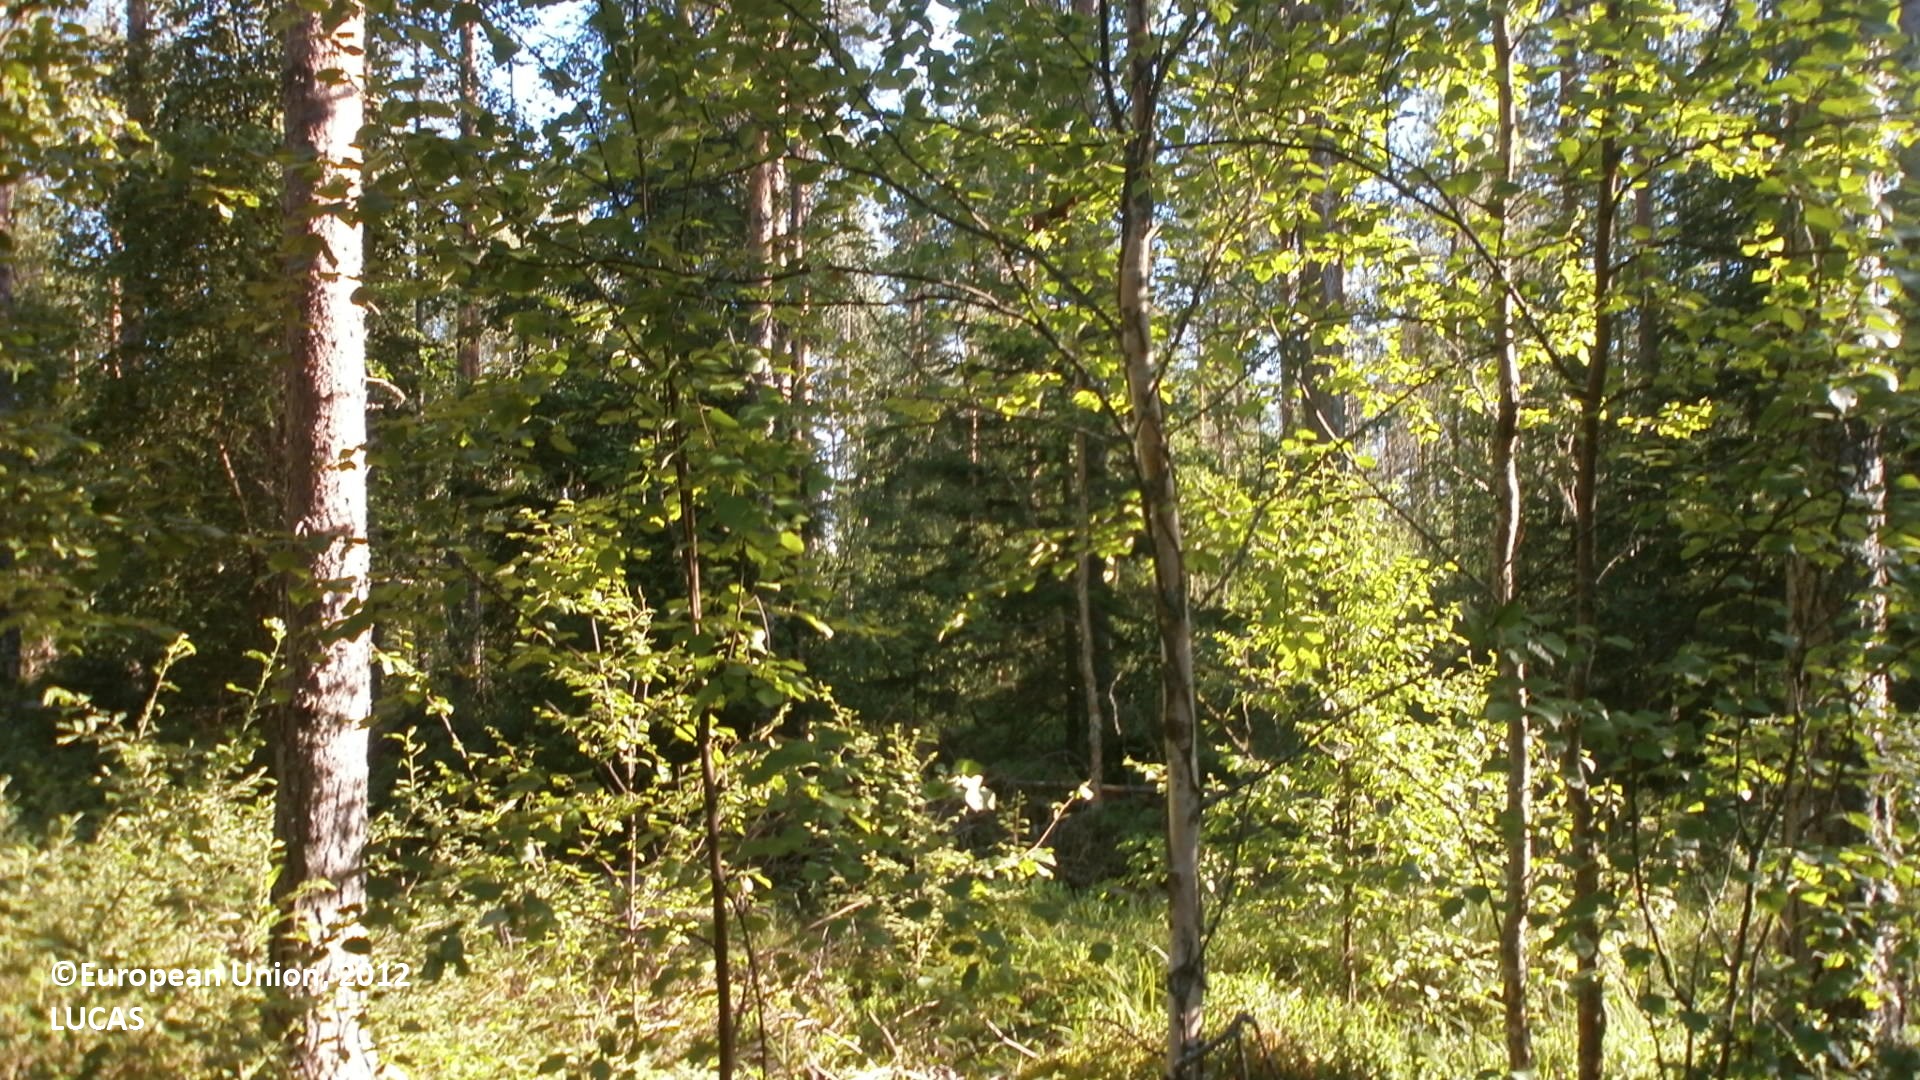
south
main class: Woodland
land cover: Pine dominated coniferous woodland
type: boreal forest
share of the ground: 50 - 75 %
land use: Forestry
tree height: > 5 m
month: July
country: FI
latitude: 64.0344
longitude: 23.9642
